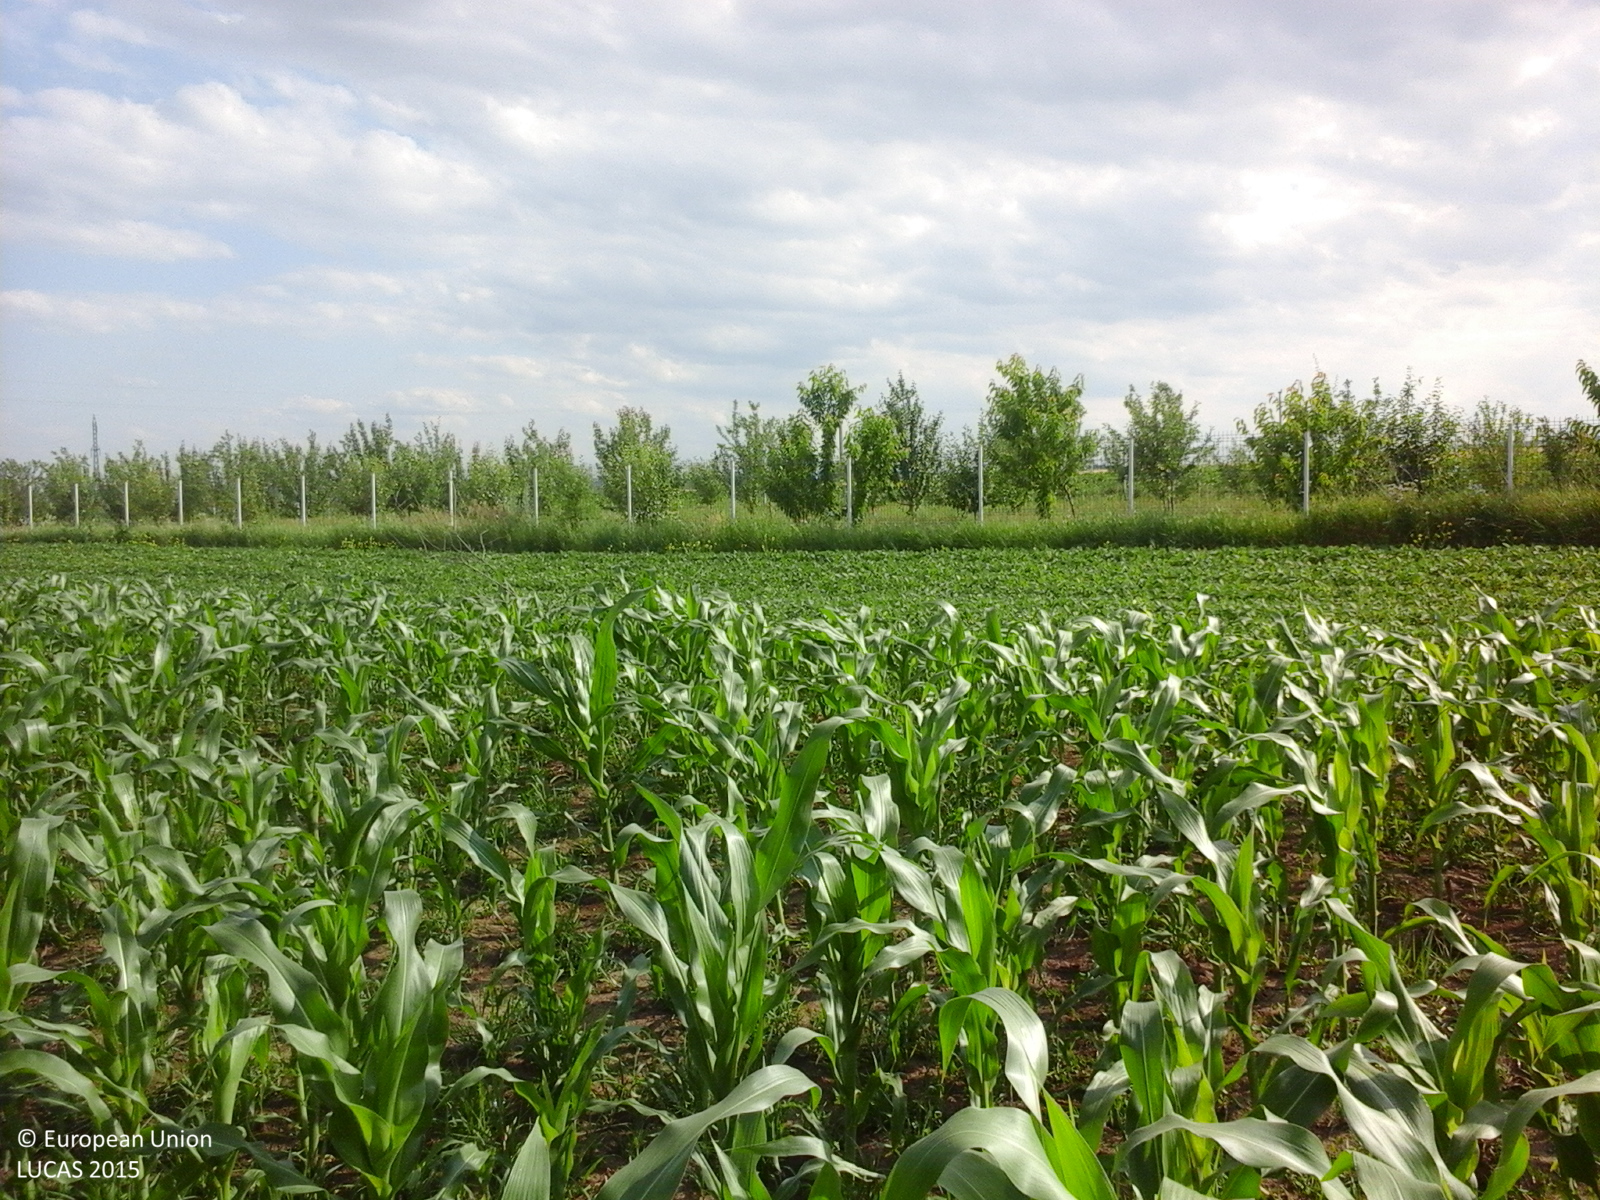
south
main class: Cropland
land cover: Other fruit trees and berries
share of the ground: > 75 %
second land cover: Grassland without tree/shrub cover
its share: > 75 %
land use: Agriculture (excluding fallow land and kitchen gardens)
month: June
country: RO
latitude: 47.9632
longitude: 26.3606
